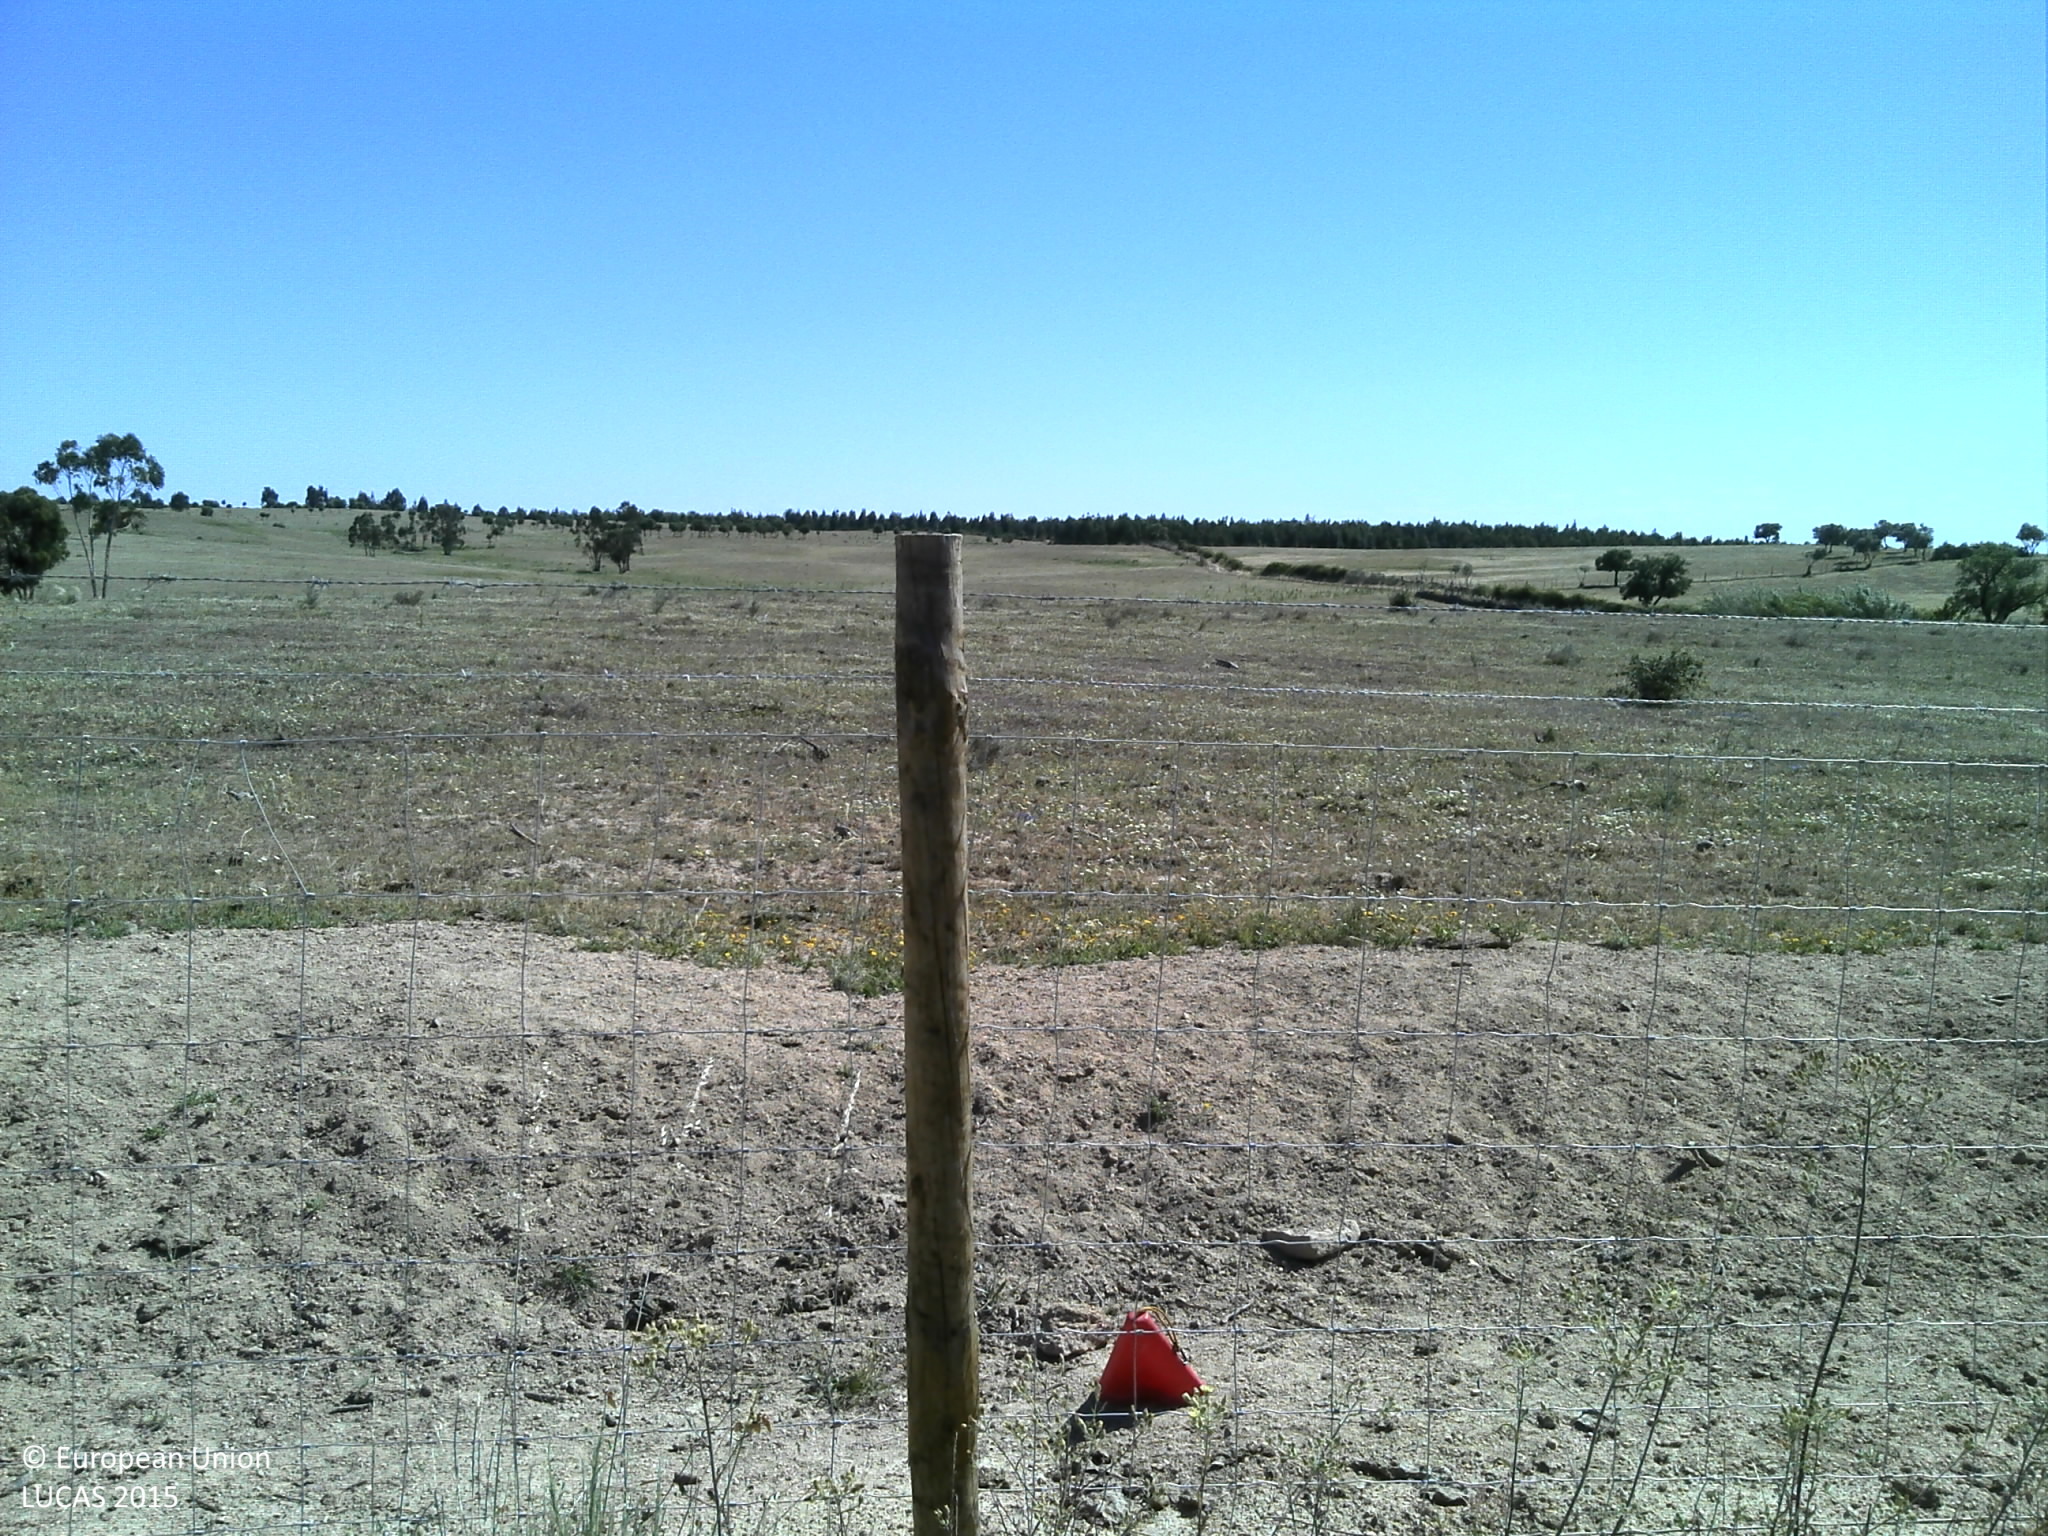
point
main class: Grassland
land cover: Grassland without tree/shrub cover
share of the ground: 25 - 50 %
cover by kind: herbaceous plants 50 %, unconsolidated bare surface 50 %
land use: Agriculture (excluding fallow land and kitchen gardens)
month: May
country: PT
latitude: 39.4027
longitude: -7.6895
